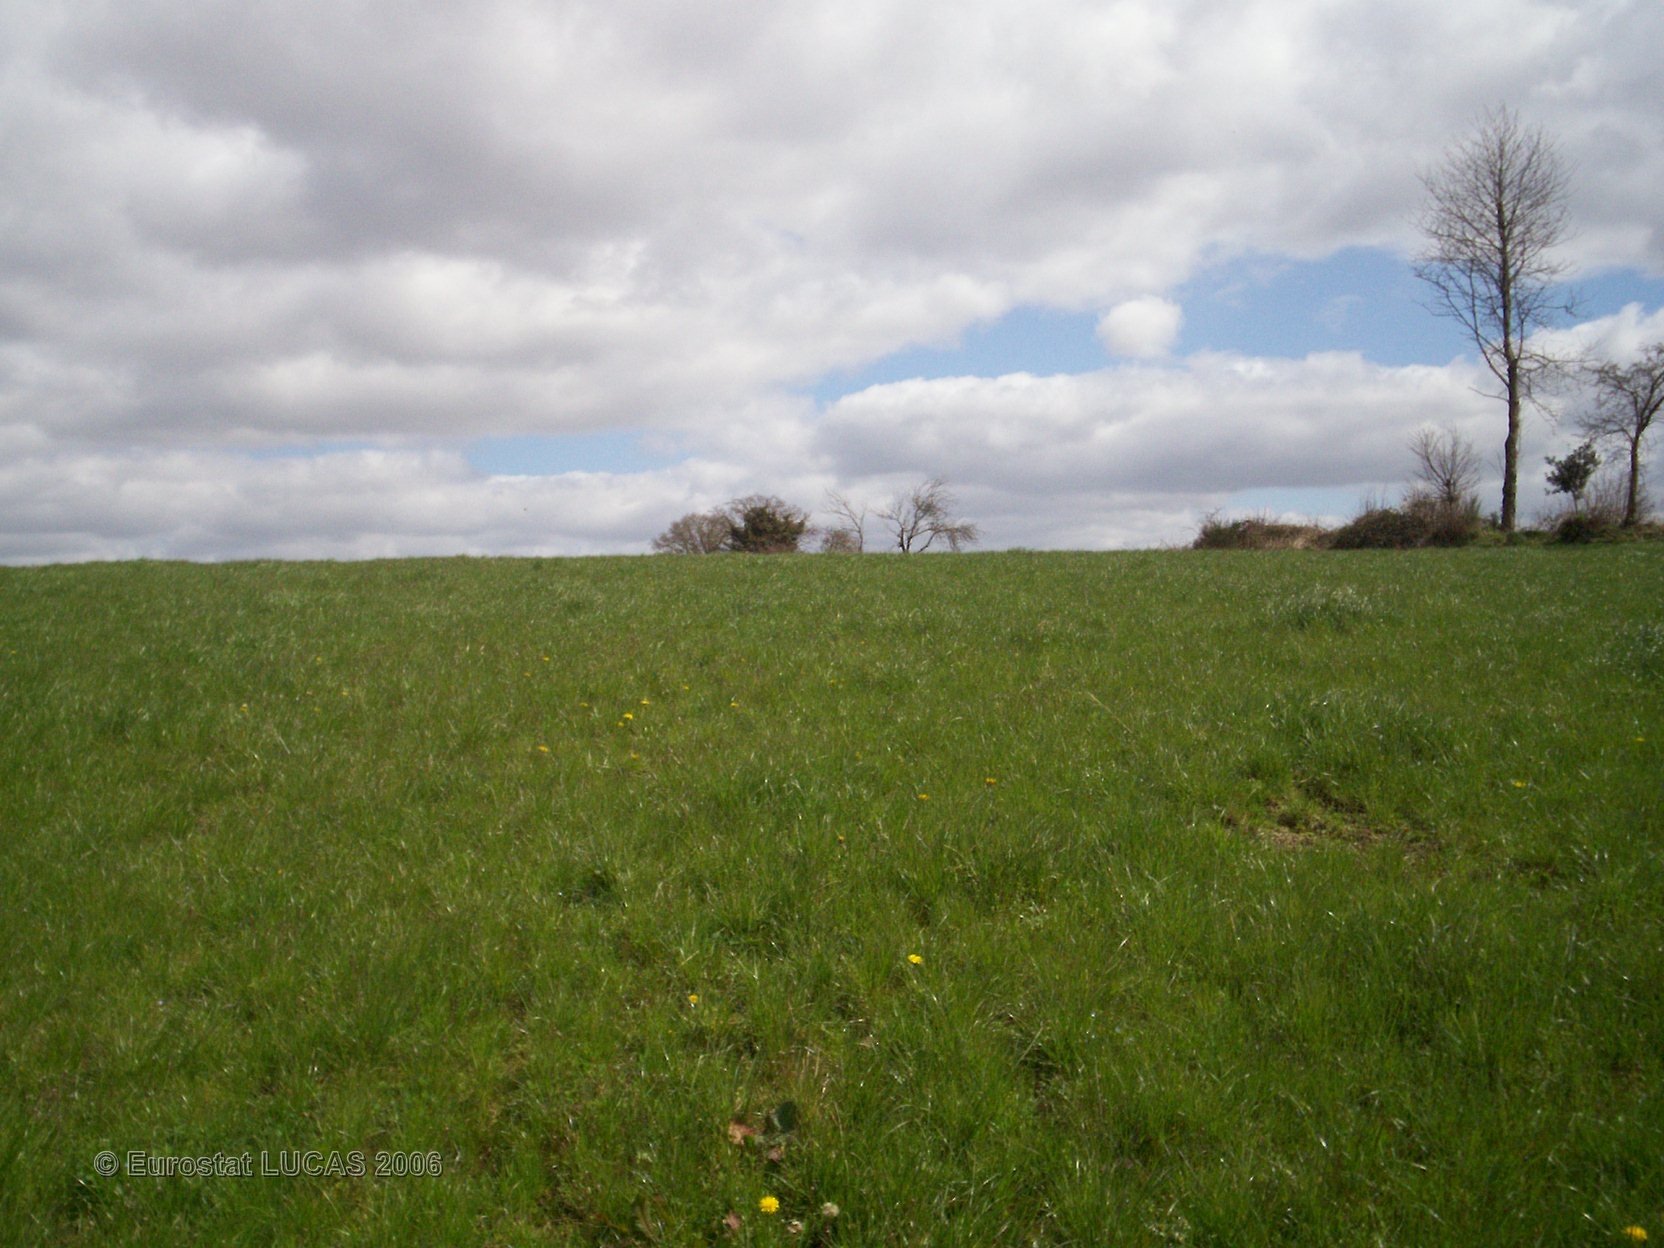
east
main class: Grassland
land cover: Grassland without tree/shrub cover
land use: Agriculture (excluding fallow land and kitchen gardens)
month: April
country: FR
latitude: 48.0987
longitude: -3.6559
